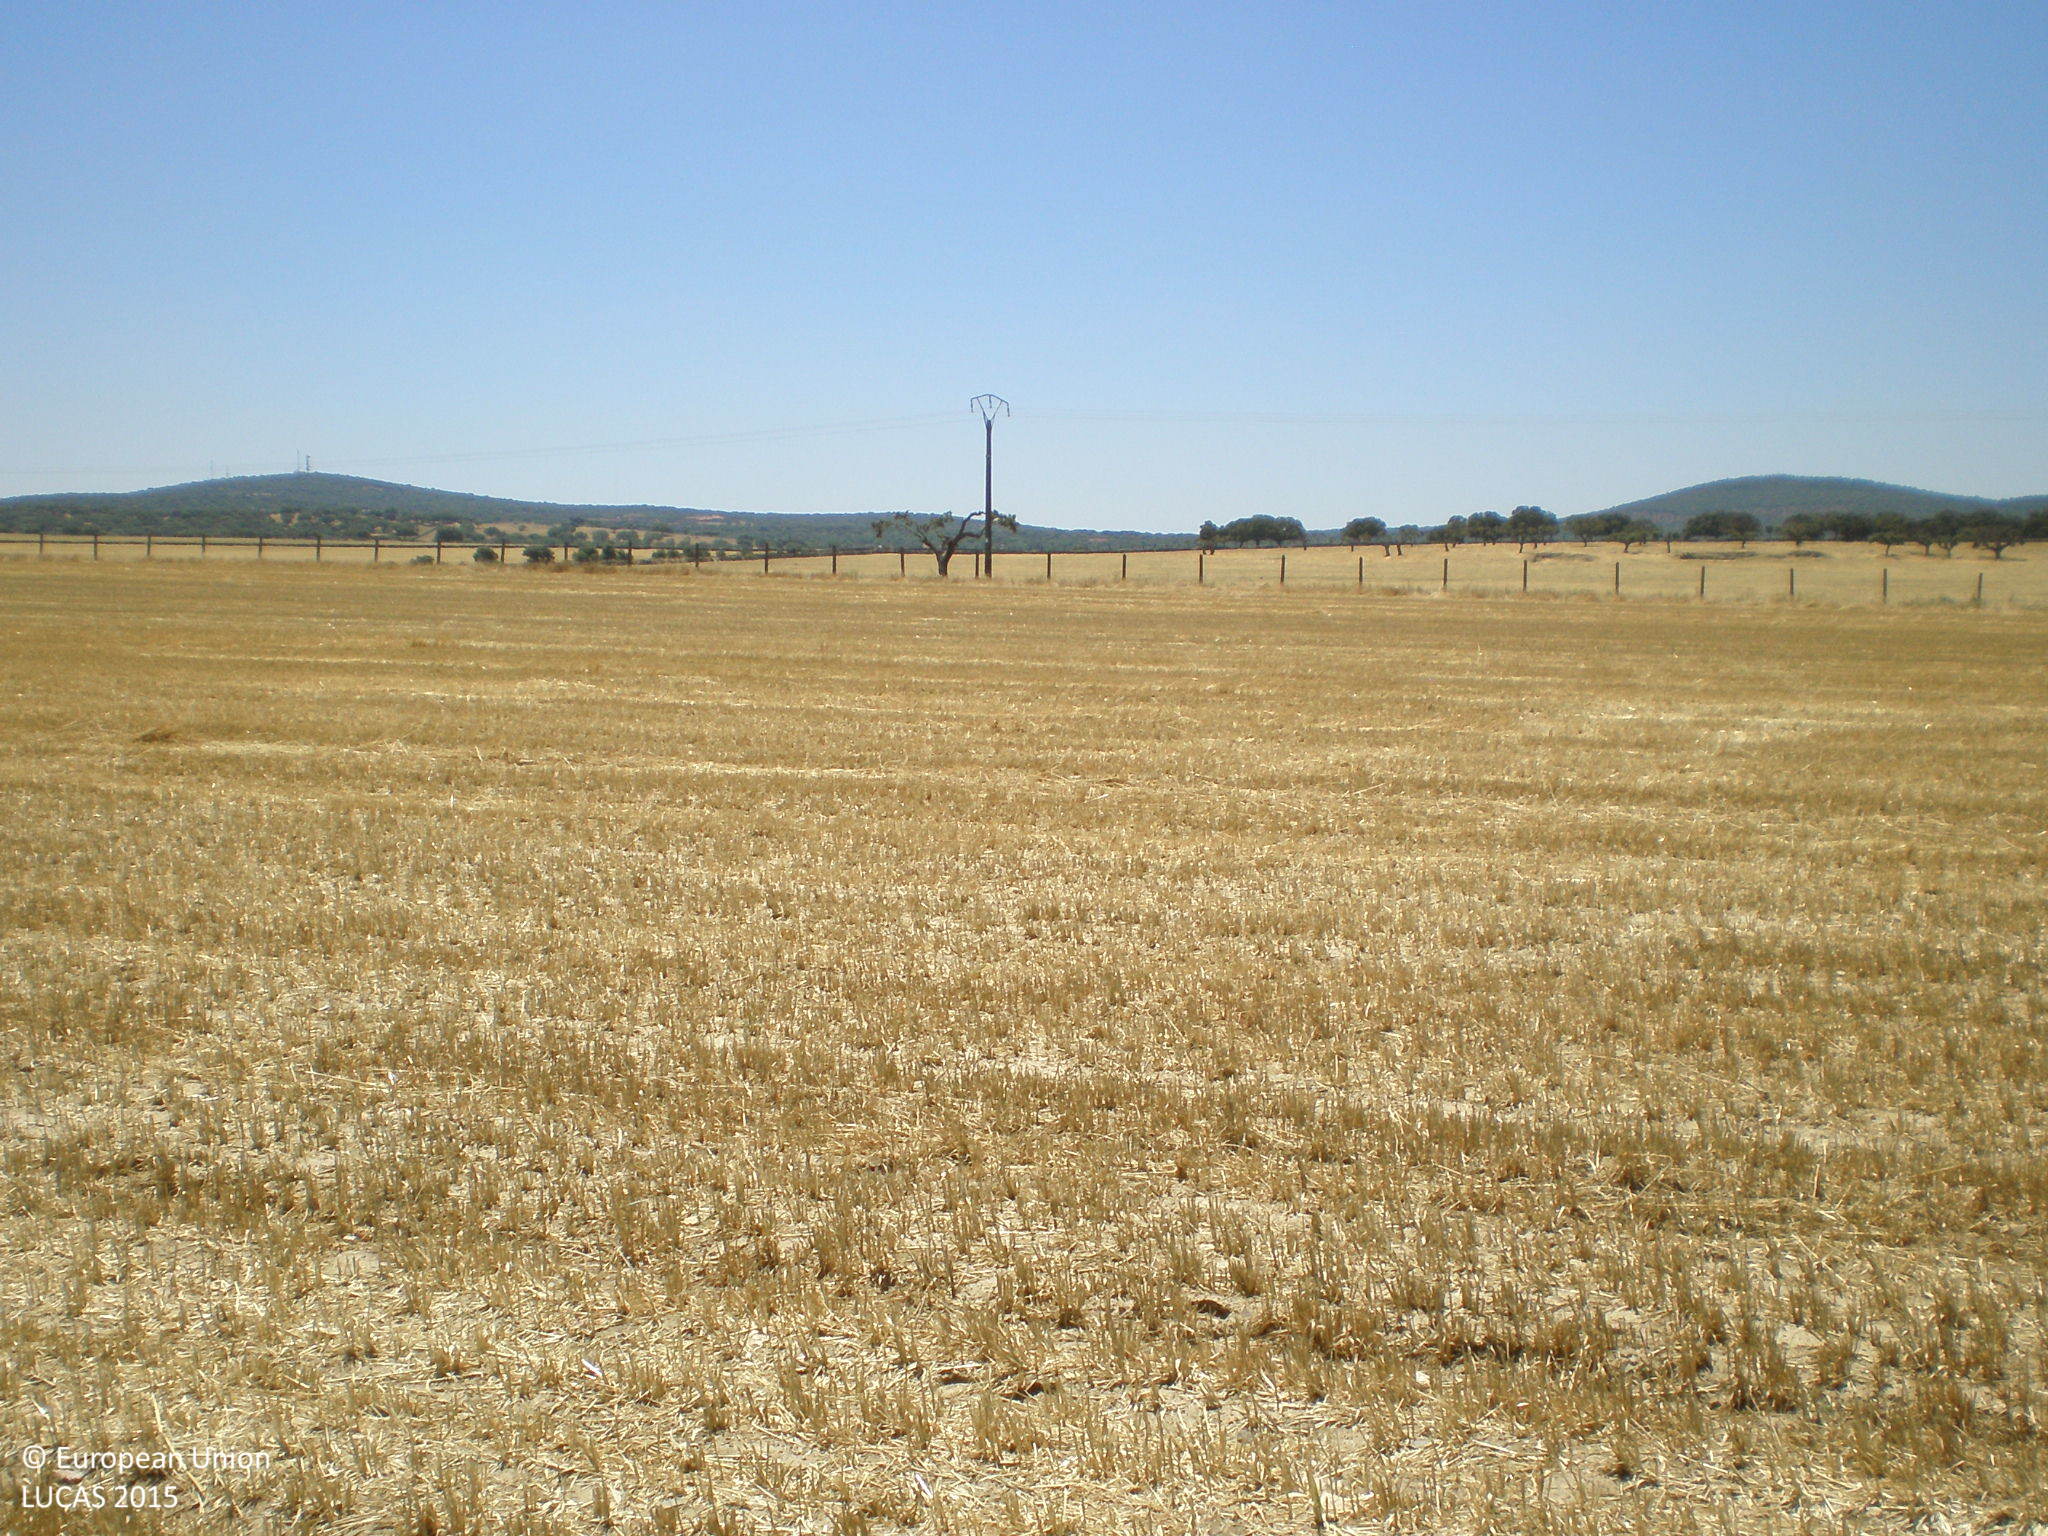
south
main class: Cropland
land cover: Oats
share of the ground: < 10 %
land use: Agriculture (excluding fallow land and kitchen gardens)
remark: Harvested field
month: June
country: ES
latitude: 40.7547
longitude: -5.8430
